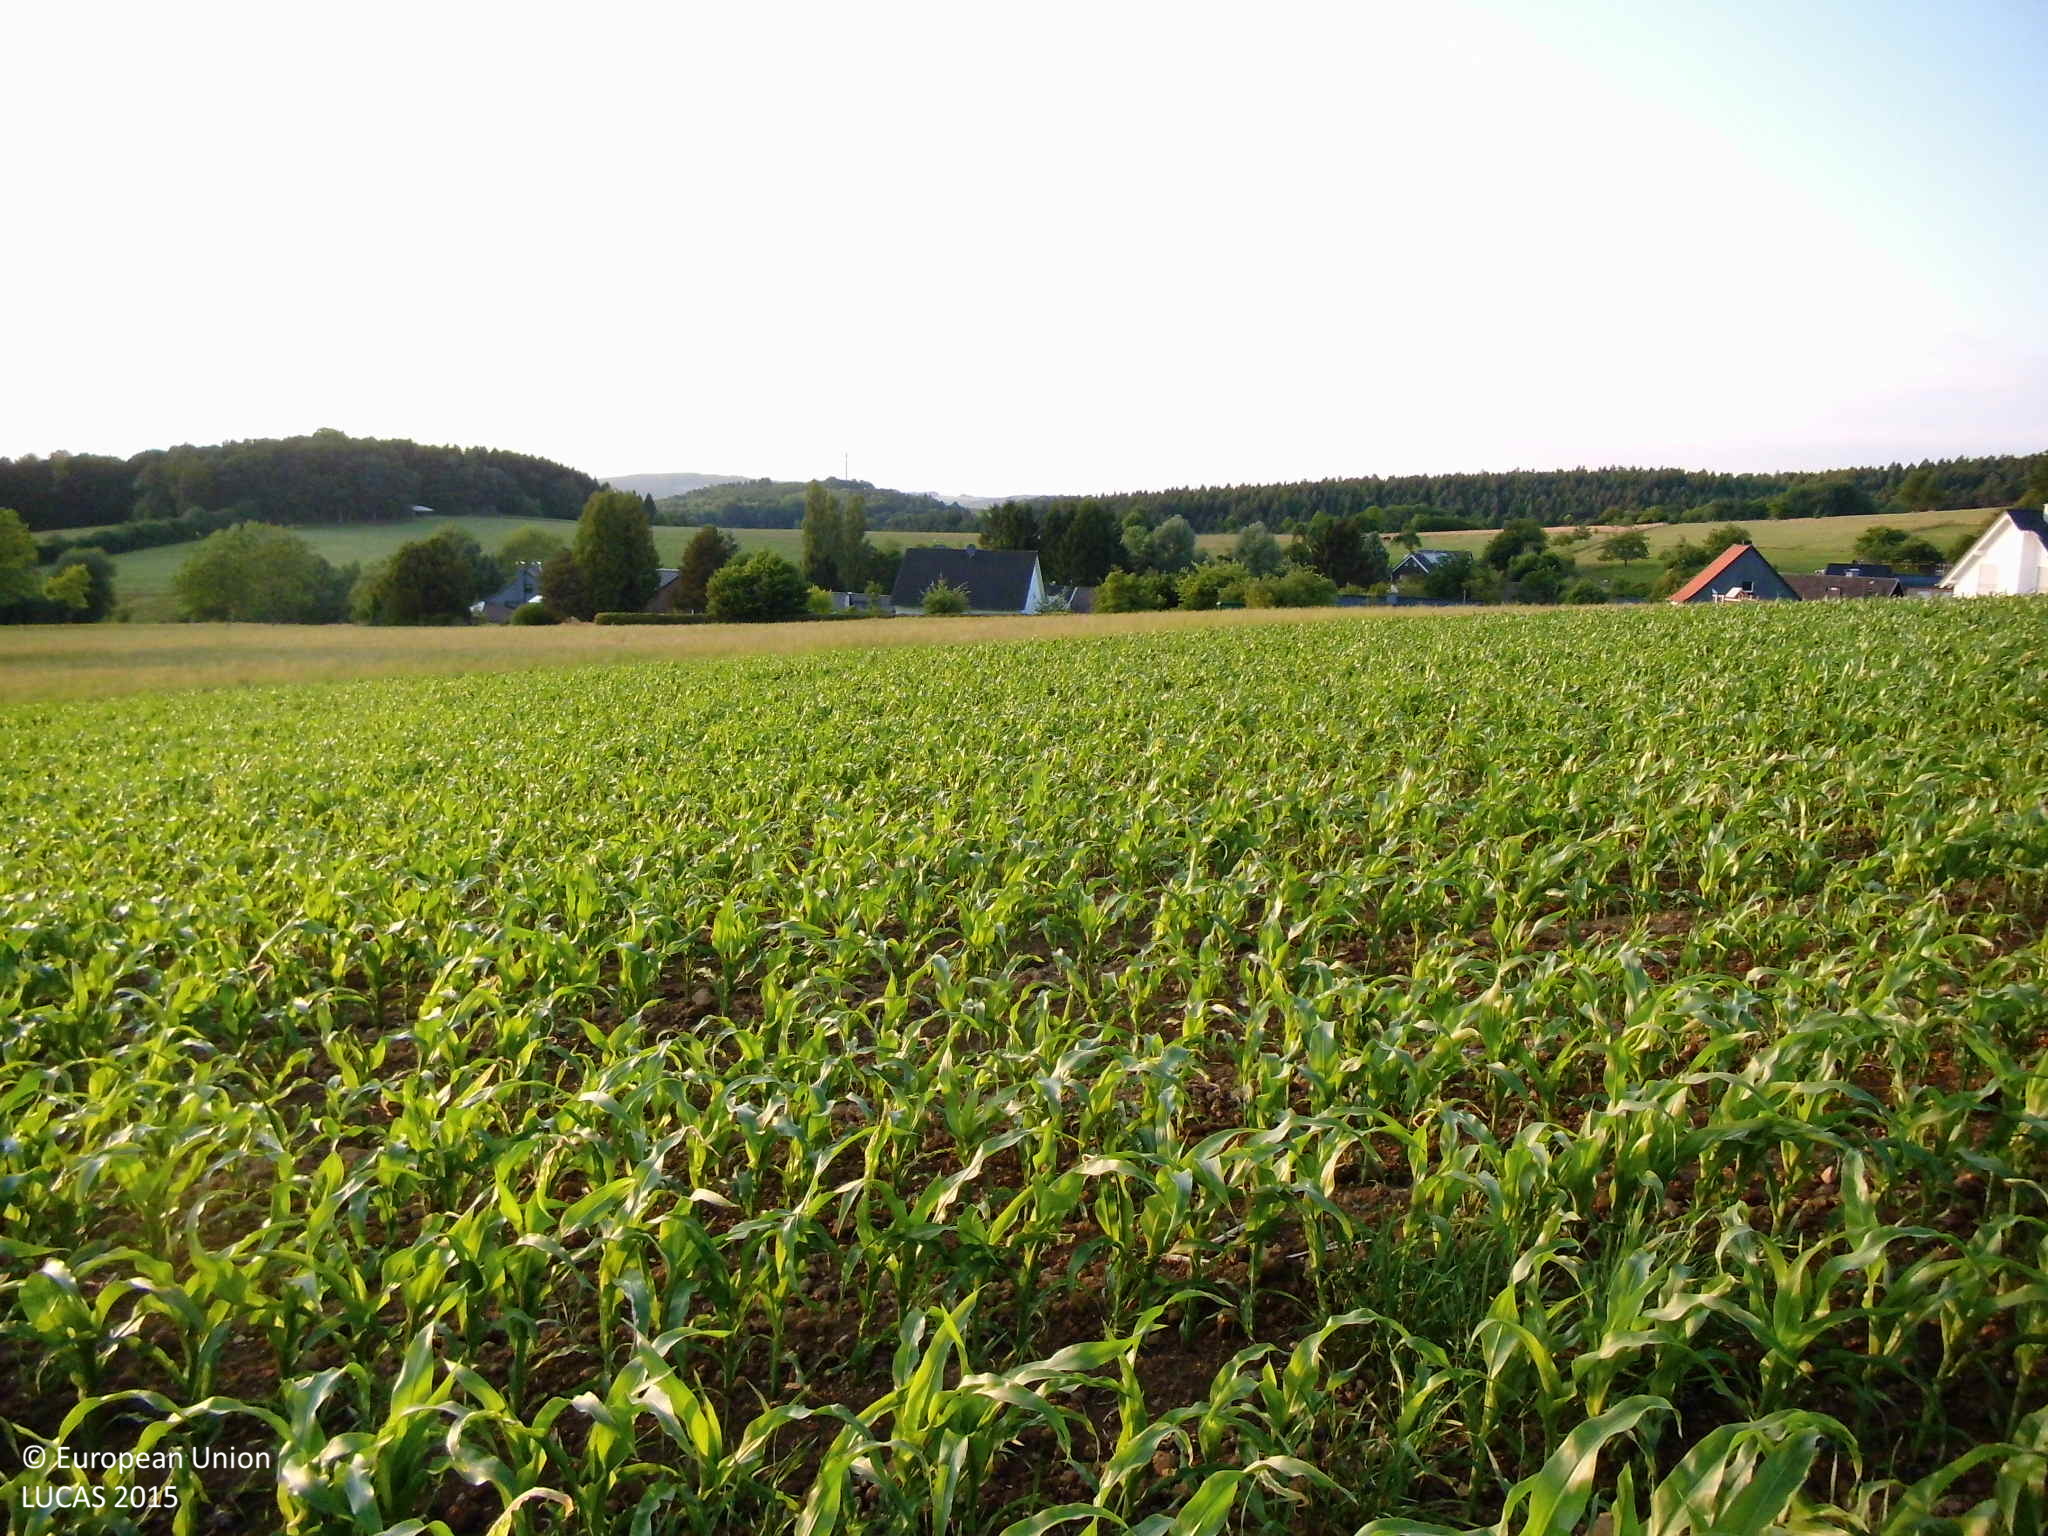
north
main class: Cropland
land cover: Maize
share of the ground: 50 - 75 %
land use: Agriculture (excluding fallow land and kitchen gardens)
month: June
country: DE
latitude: 50.8575
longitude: 7.4573
